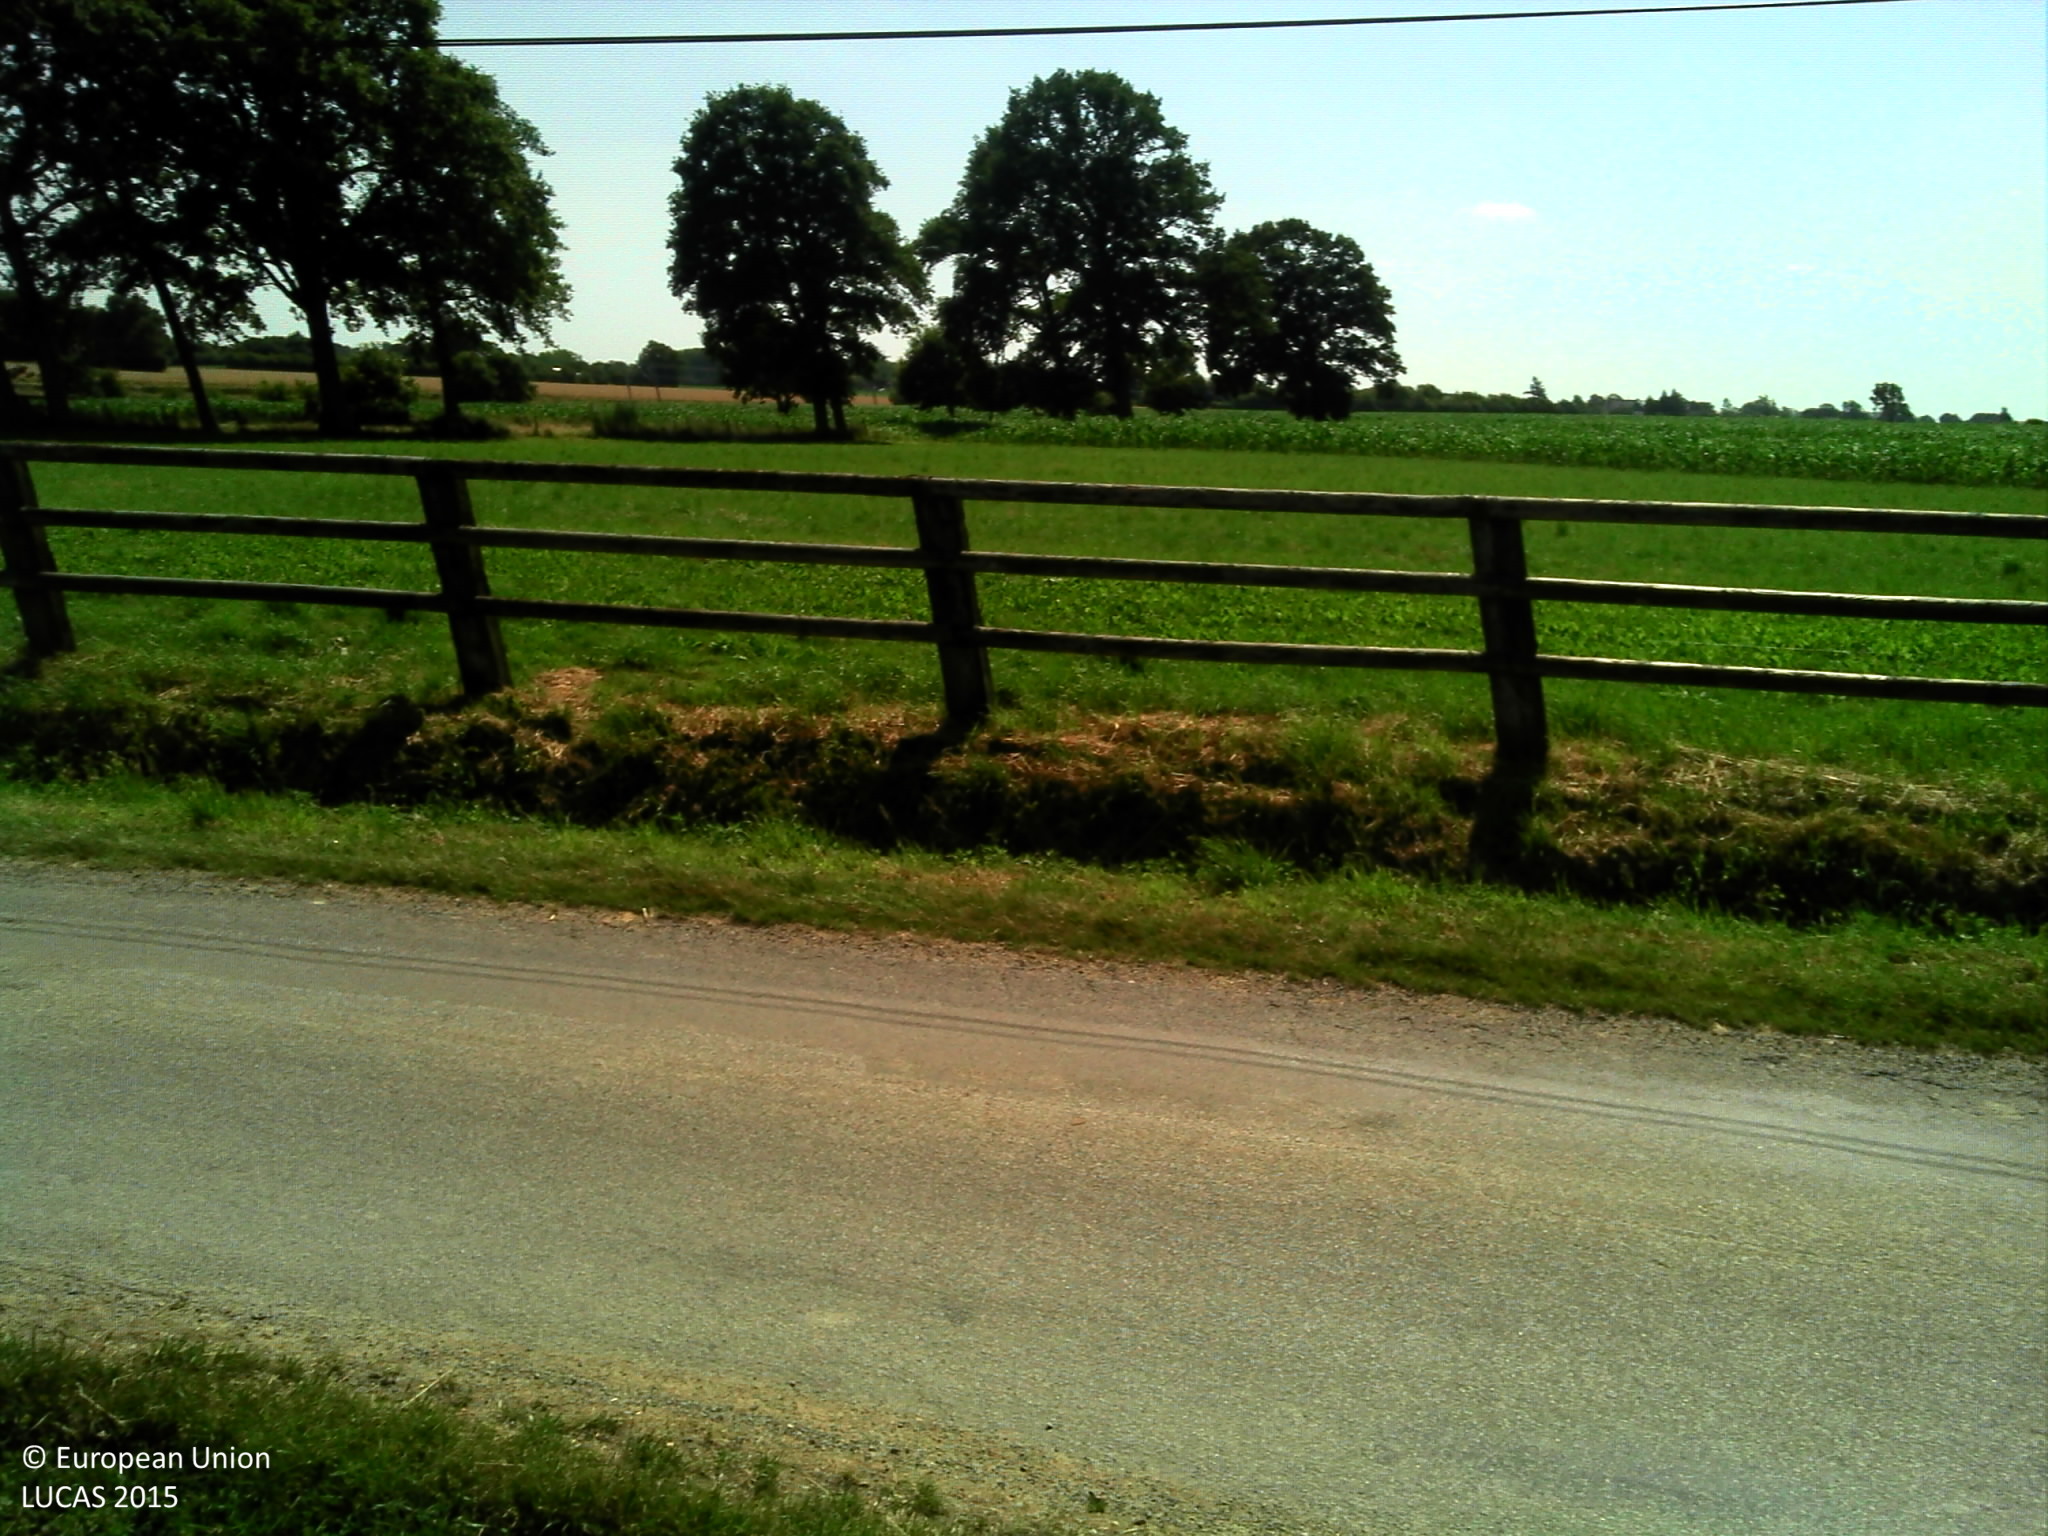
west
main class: Grassland
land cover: Grassland without tree/shrub cover
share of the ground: > 75 %
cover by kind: herbaceous plants 100 %
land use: Sport
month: July
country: FR
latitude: 48.0515
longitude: -1.1900
